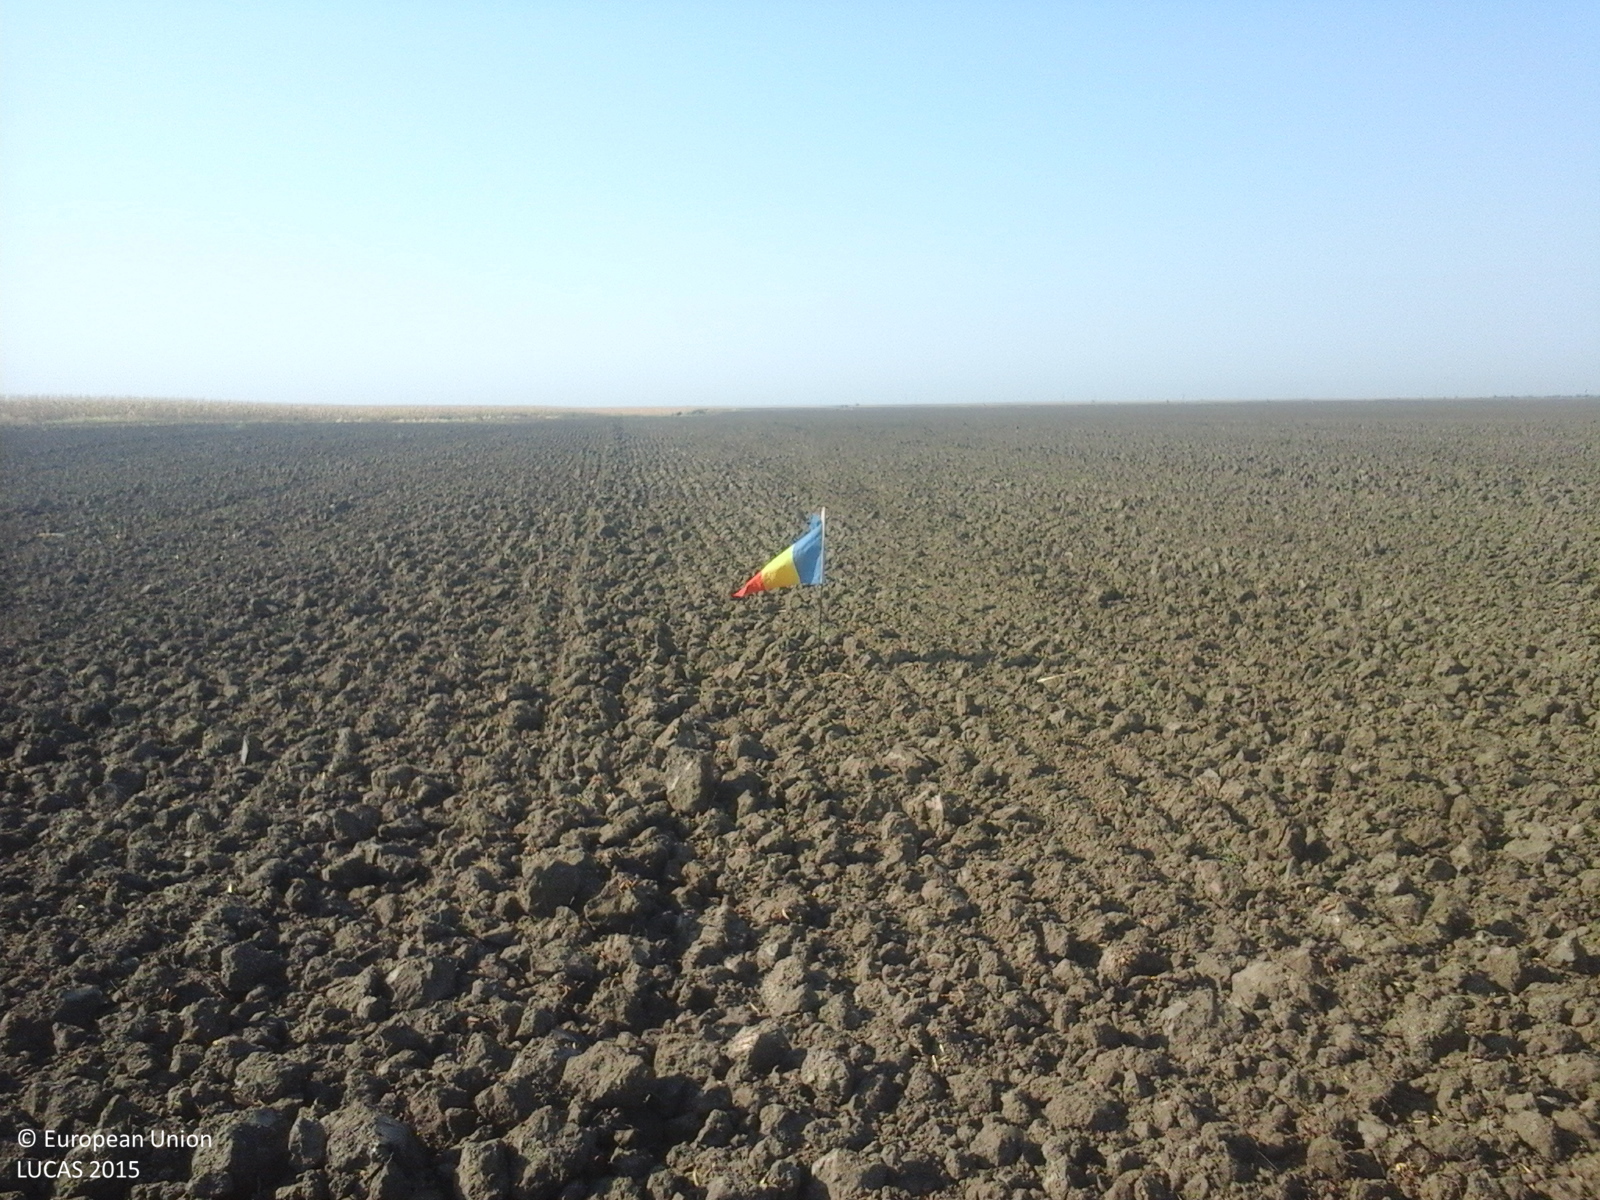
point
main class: Cropland
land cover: Barley
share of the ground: < 10 %
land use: Agriculture (excluding fallow land and kitchen gardens)
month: August
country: RO
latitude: 44.2016
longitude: 23.0197
